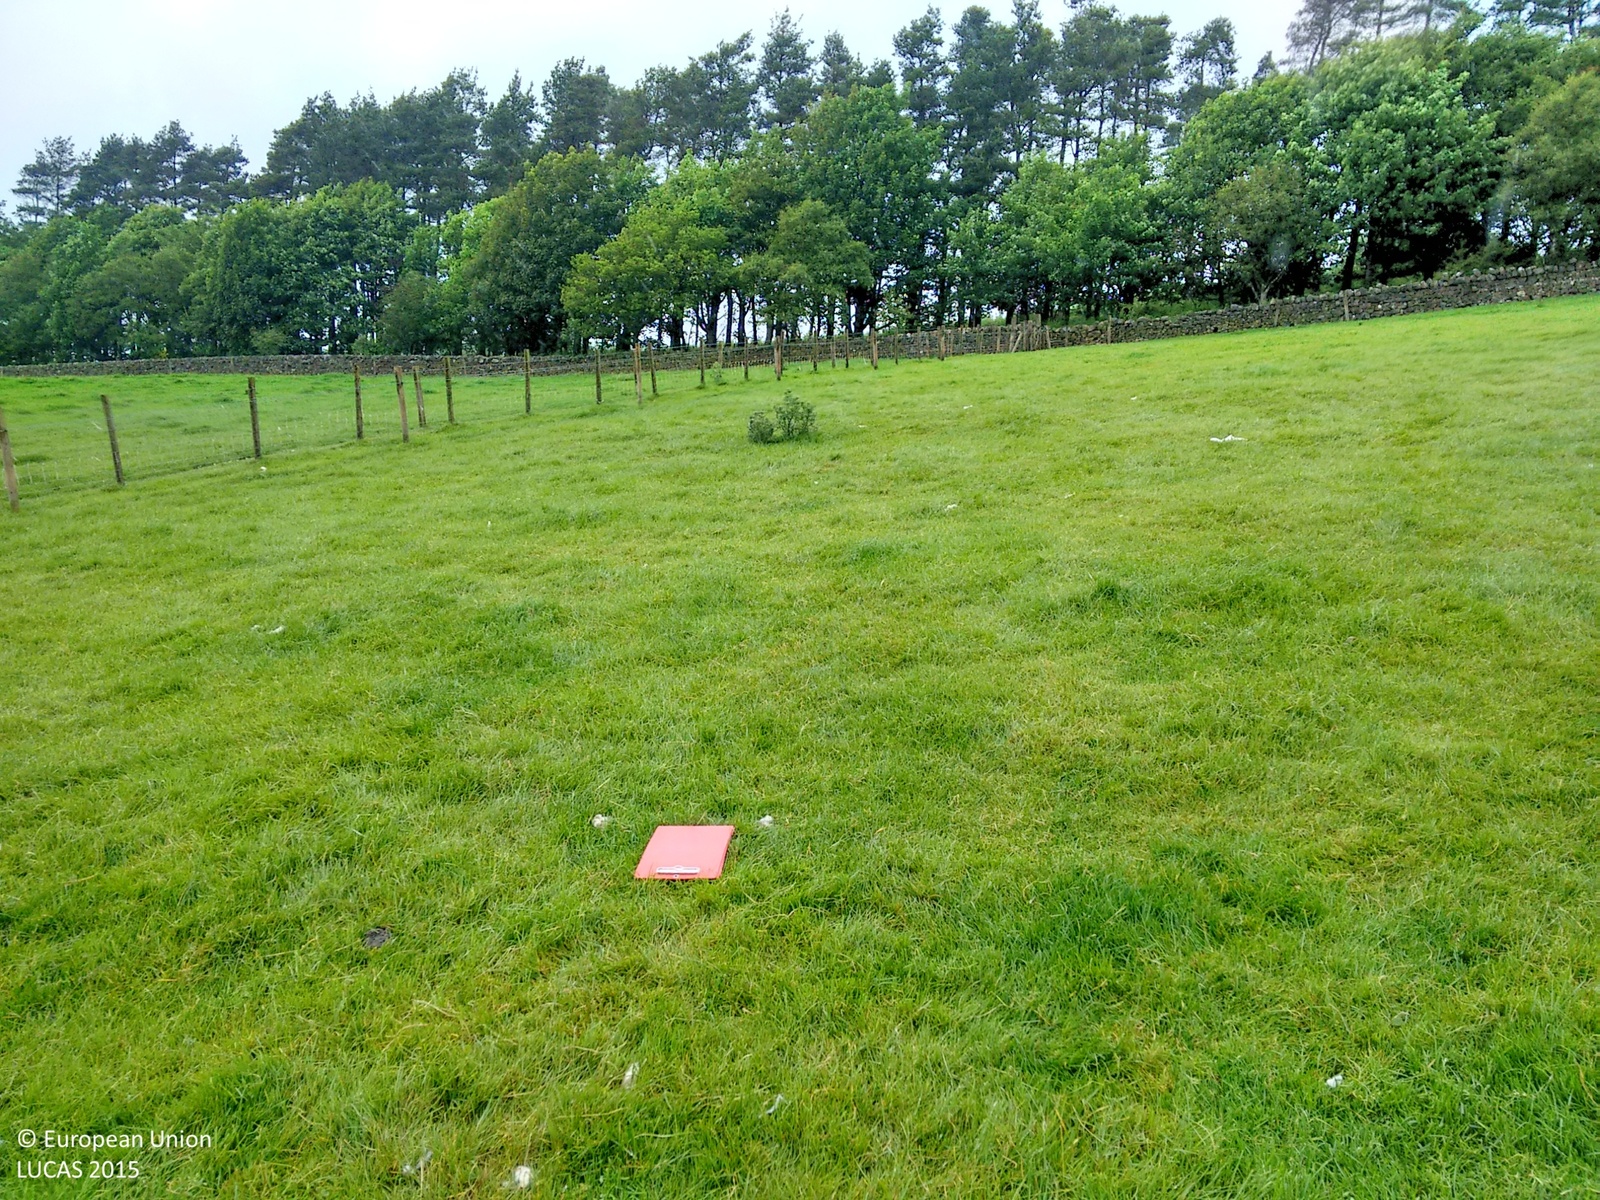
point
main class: Grassland
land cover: Grassland without tree/shrub cover
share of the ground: > 75 %
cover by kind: herbaceous plants 100 %
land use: Agriculture (excluding fallow land and kitchen gardens)
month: June
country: GB
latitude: 55.0353
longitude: -3.2981
